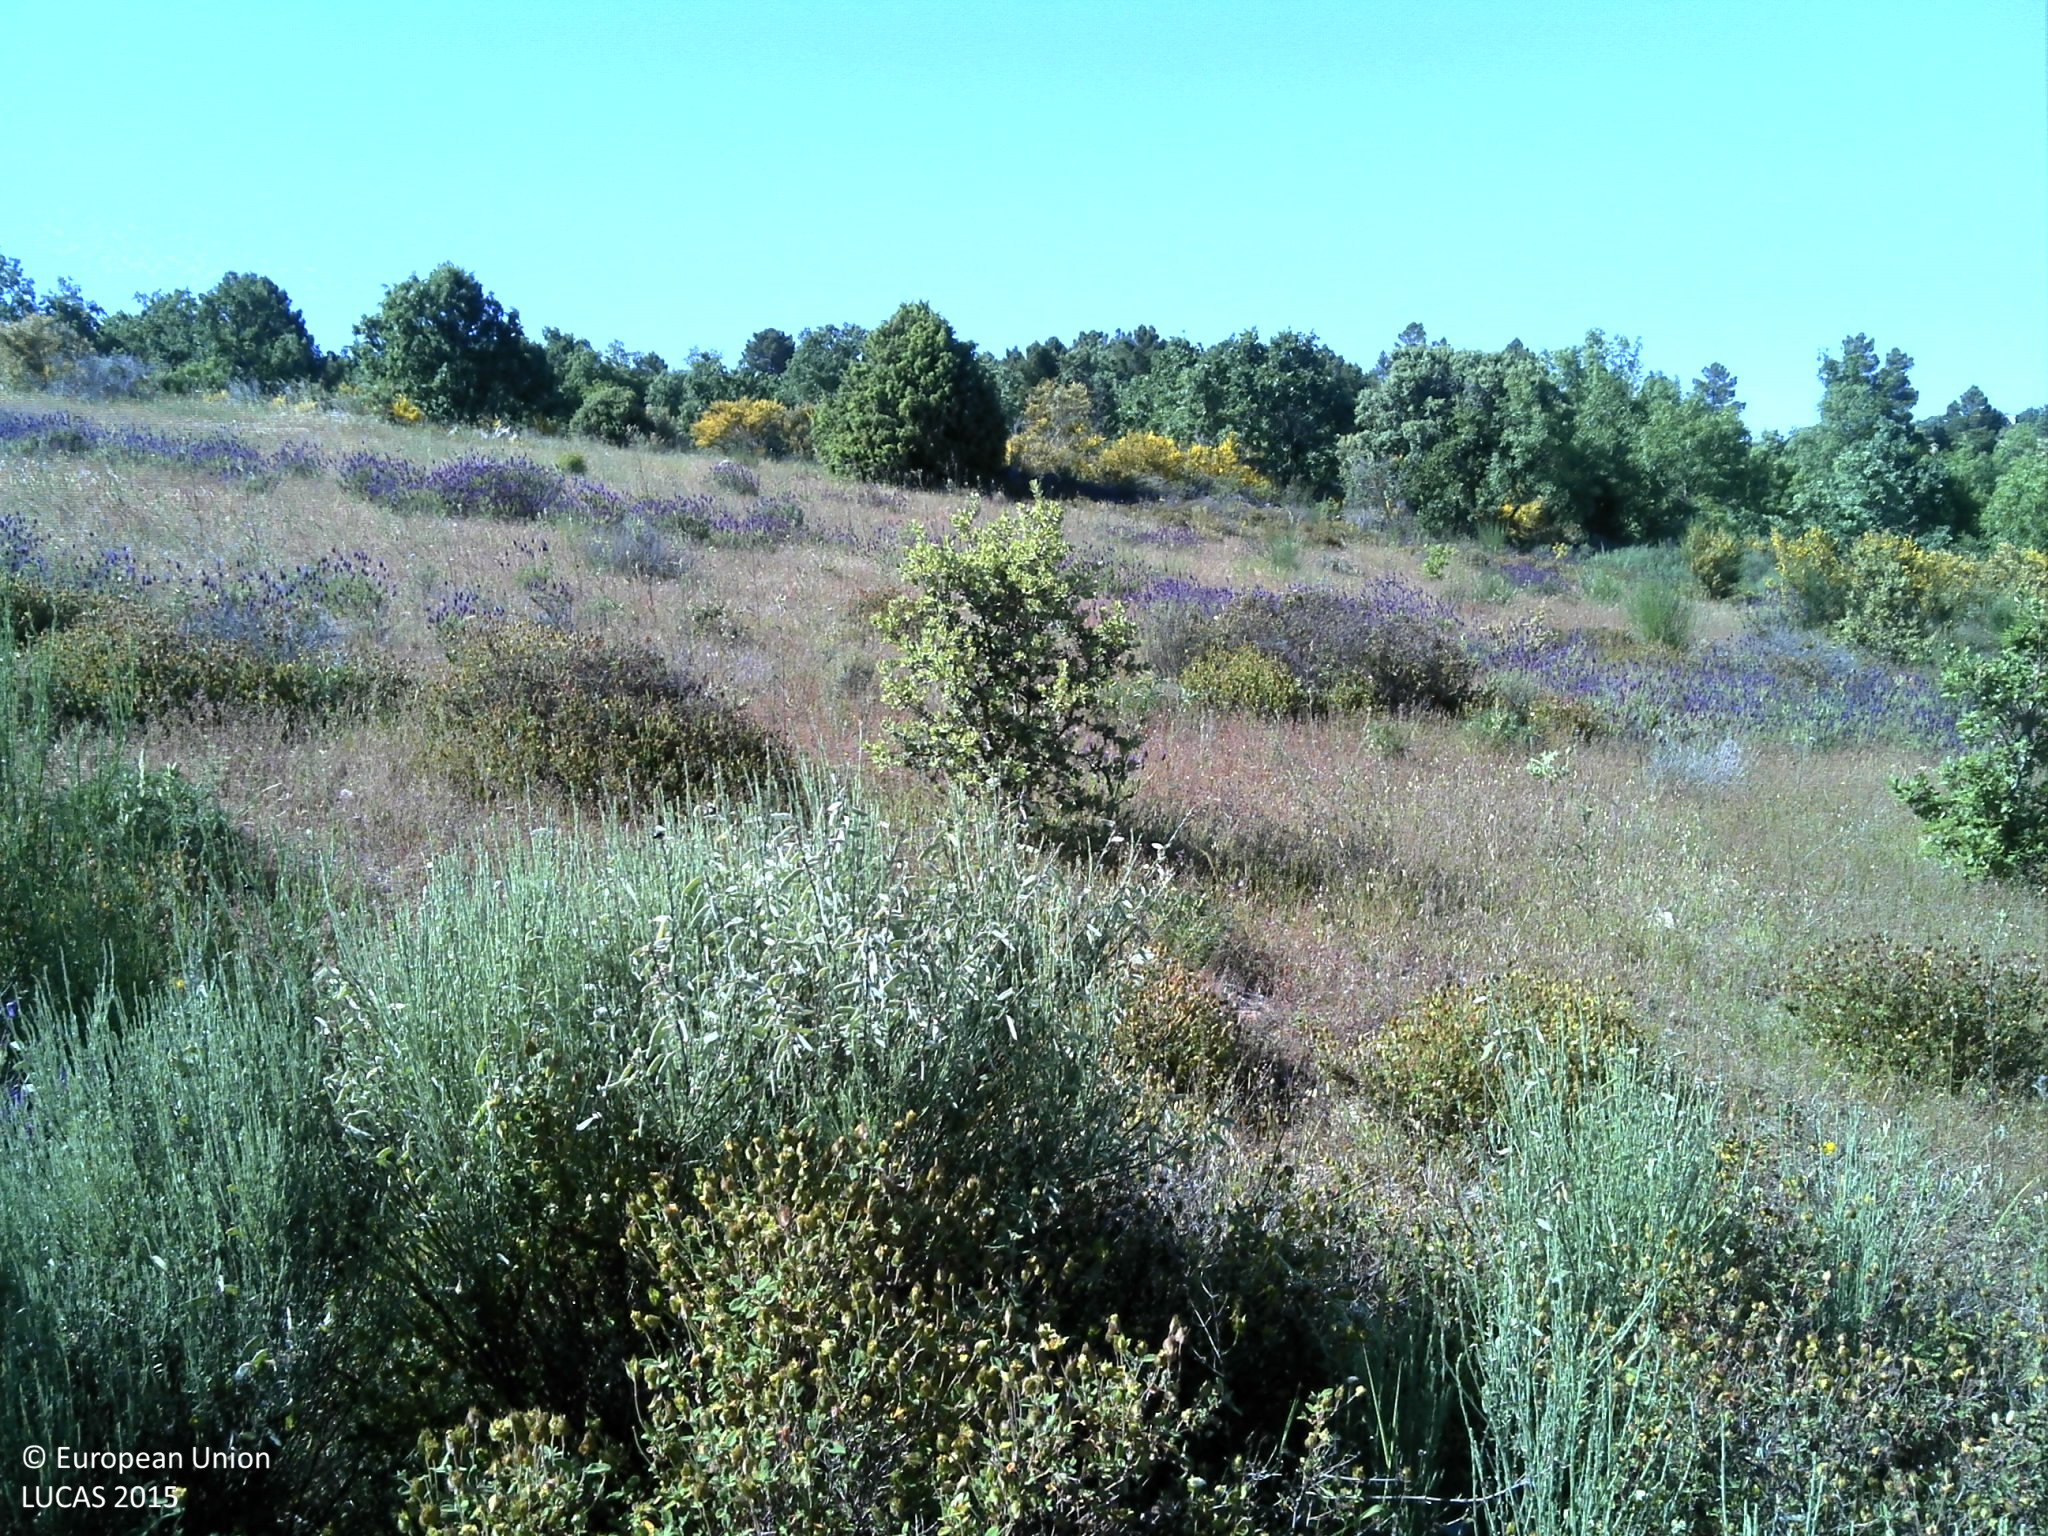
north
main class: Shrubland
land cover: Shrubland without tree cover
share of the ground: 25 - 50 %
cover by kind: shrubs 50 %, unconsolidated bare surface 30 %, herbaceous plants 20 %
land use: Abandoned areas
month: May
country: PT
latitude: 41.4980
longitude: -6.3551
